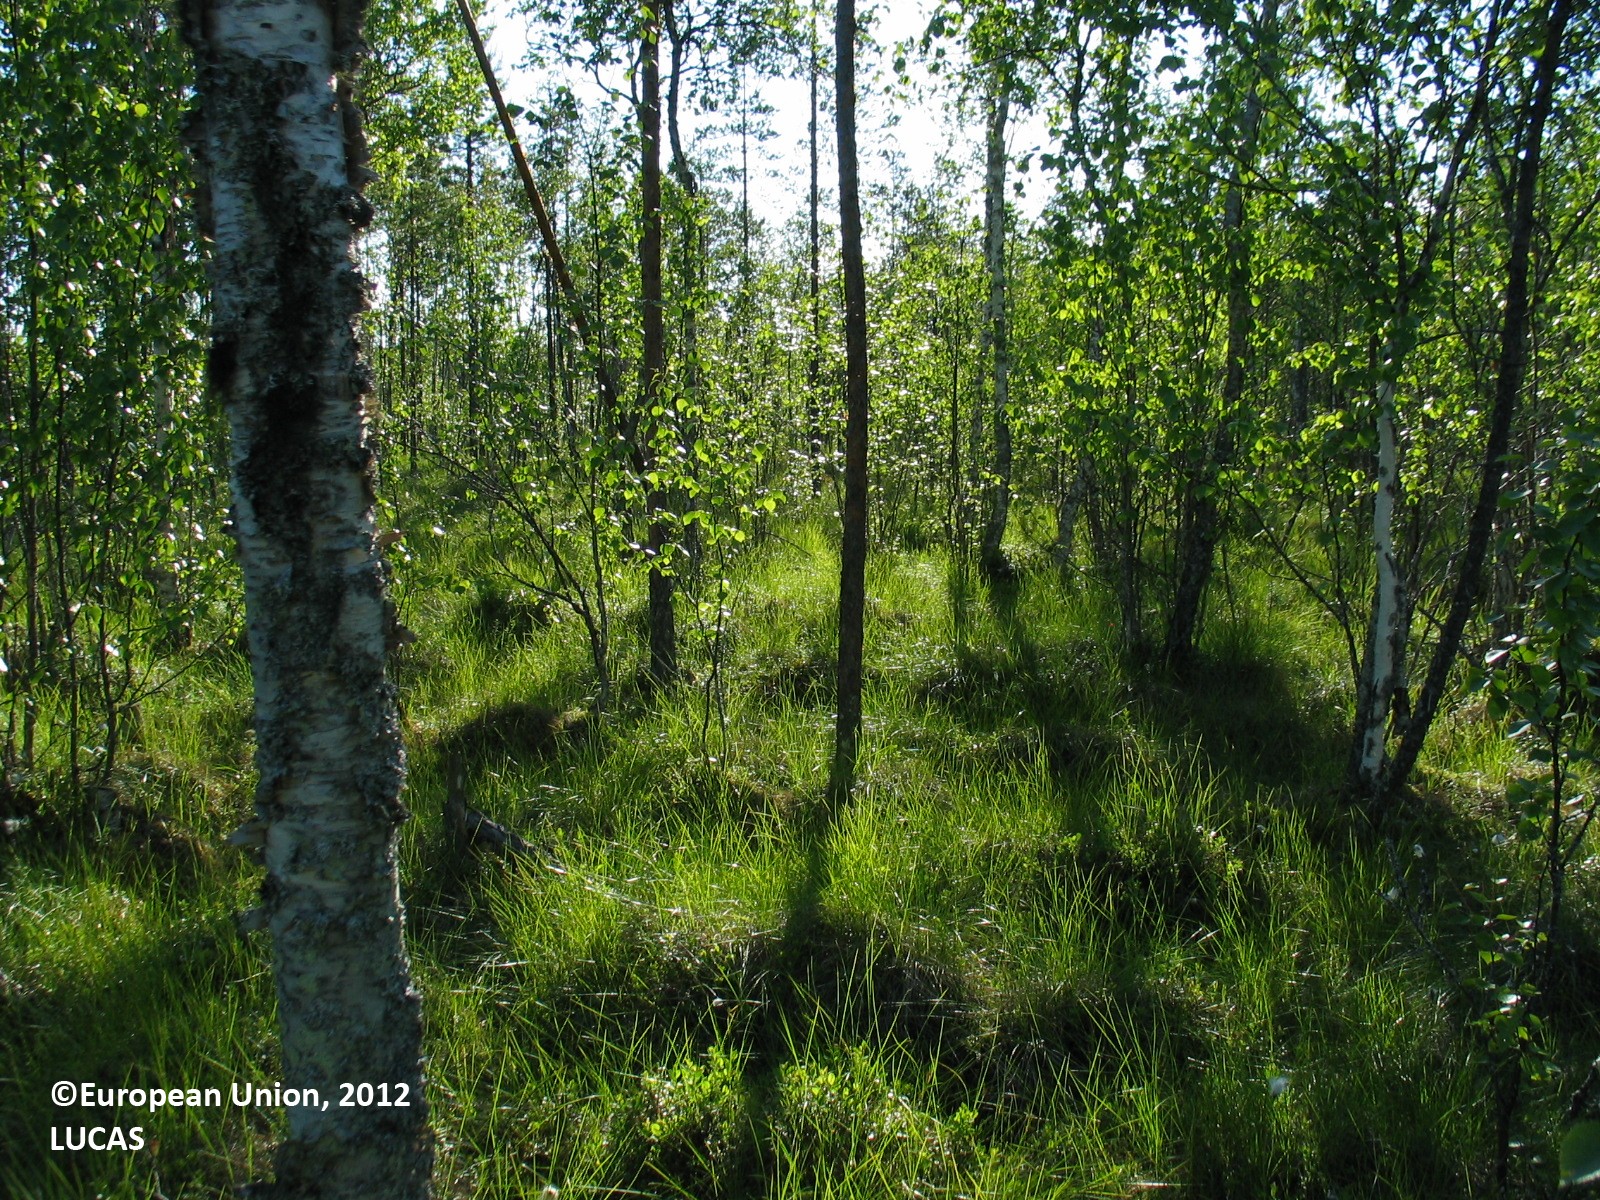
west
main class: Woodland
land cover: Other mixed woodland
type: mire and swamp forests
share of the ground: 10 - 25 %
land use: Forestry
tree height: > 5 m
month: July
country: FI
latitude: 64.7648
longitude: 26.5302
